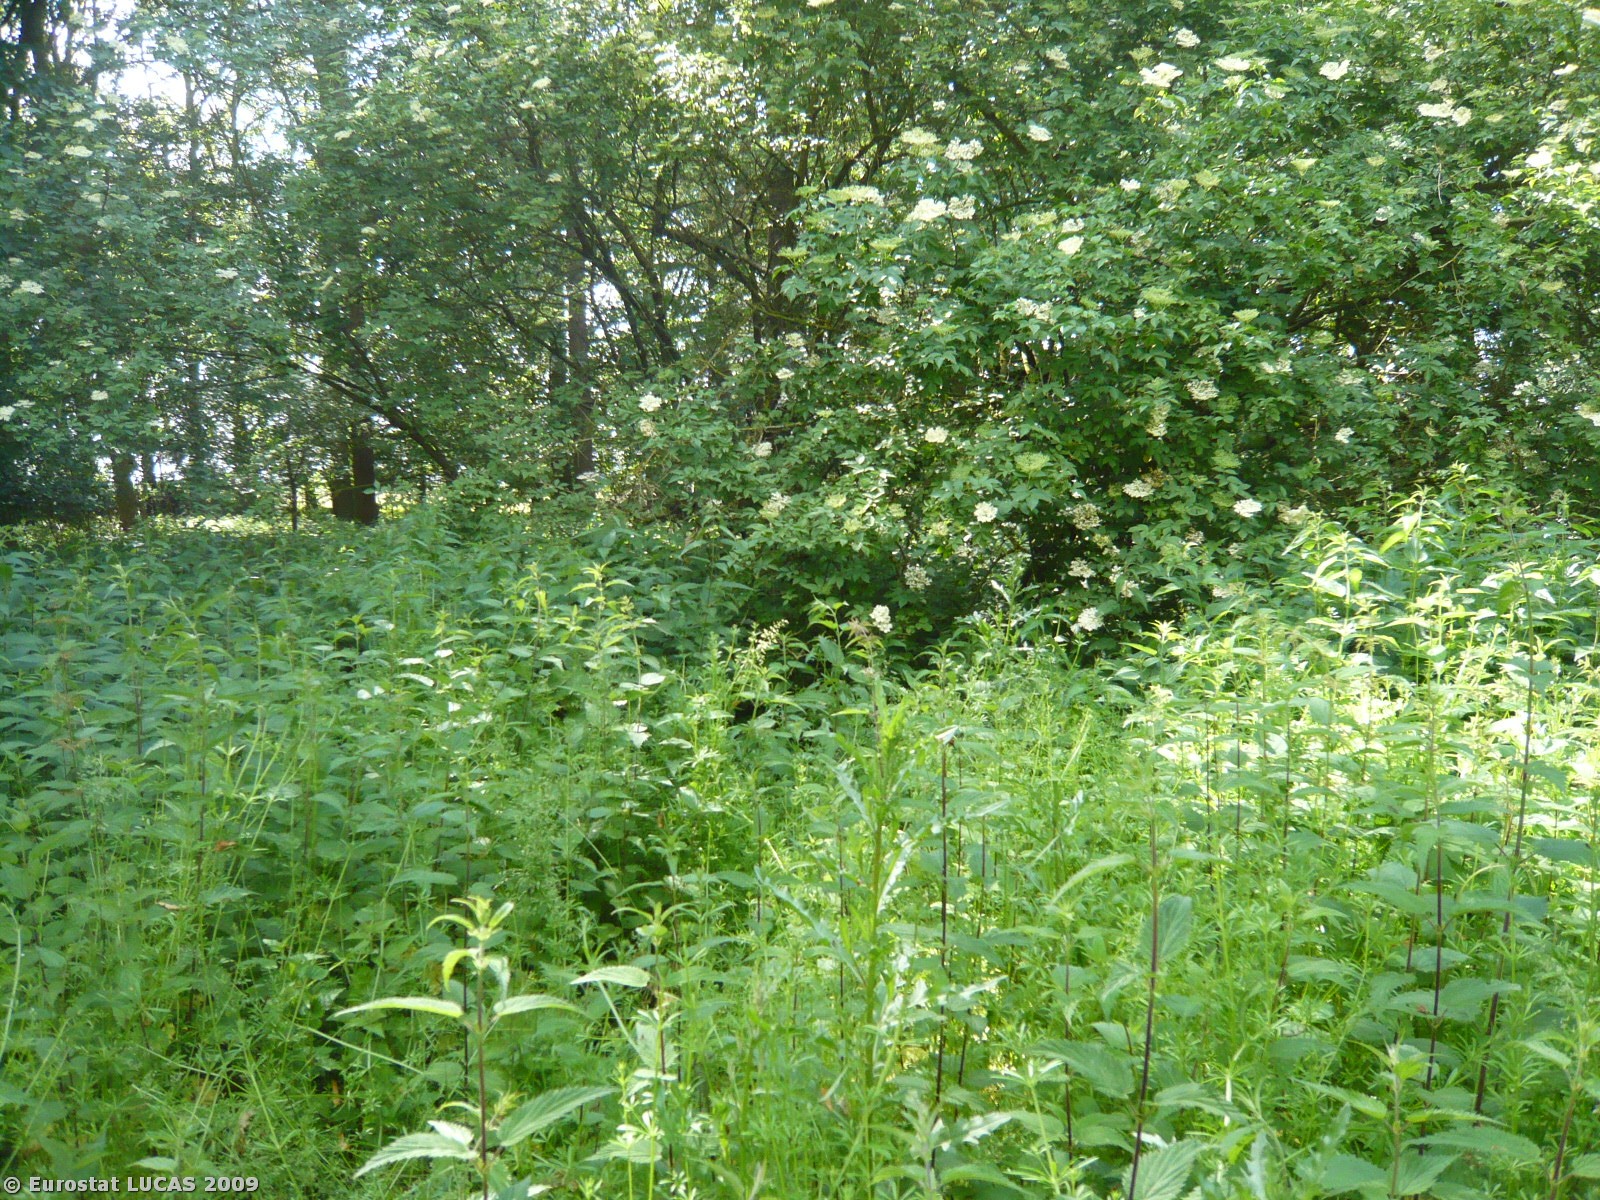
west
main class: Woodland
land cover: Broadleaved woodland
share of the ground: 50 - 75 %
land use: Residential
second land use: Amenities, museums, leisure
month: June
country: DK
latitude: 54.7404
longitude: 11.5367
